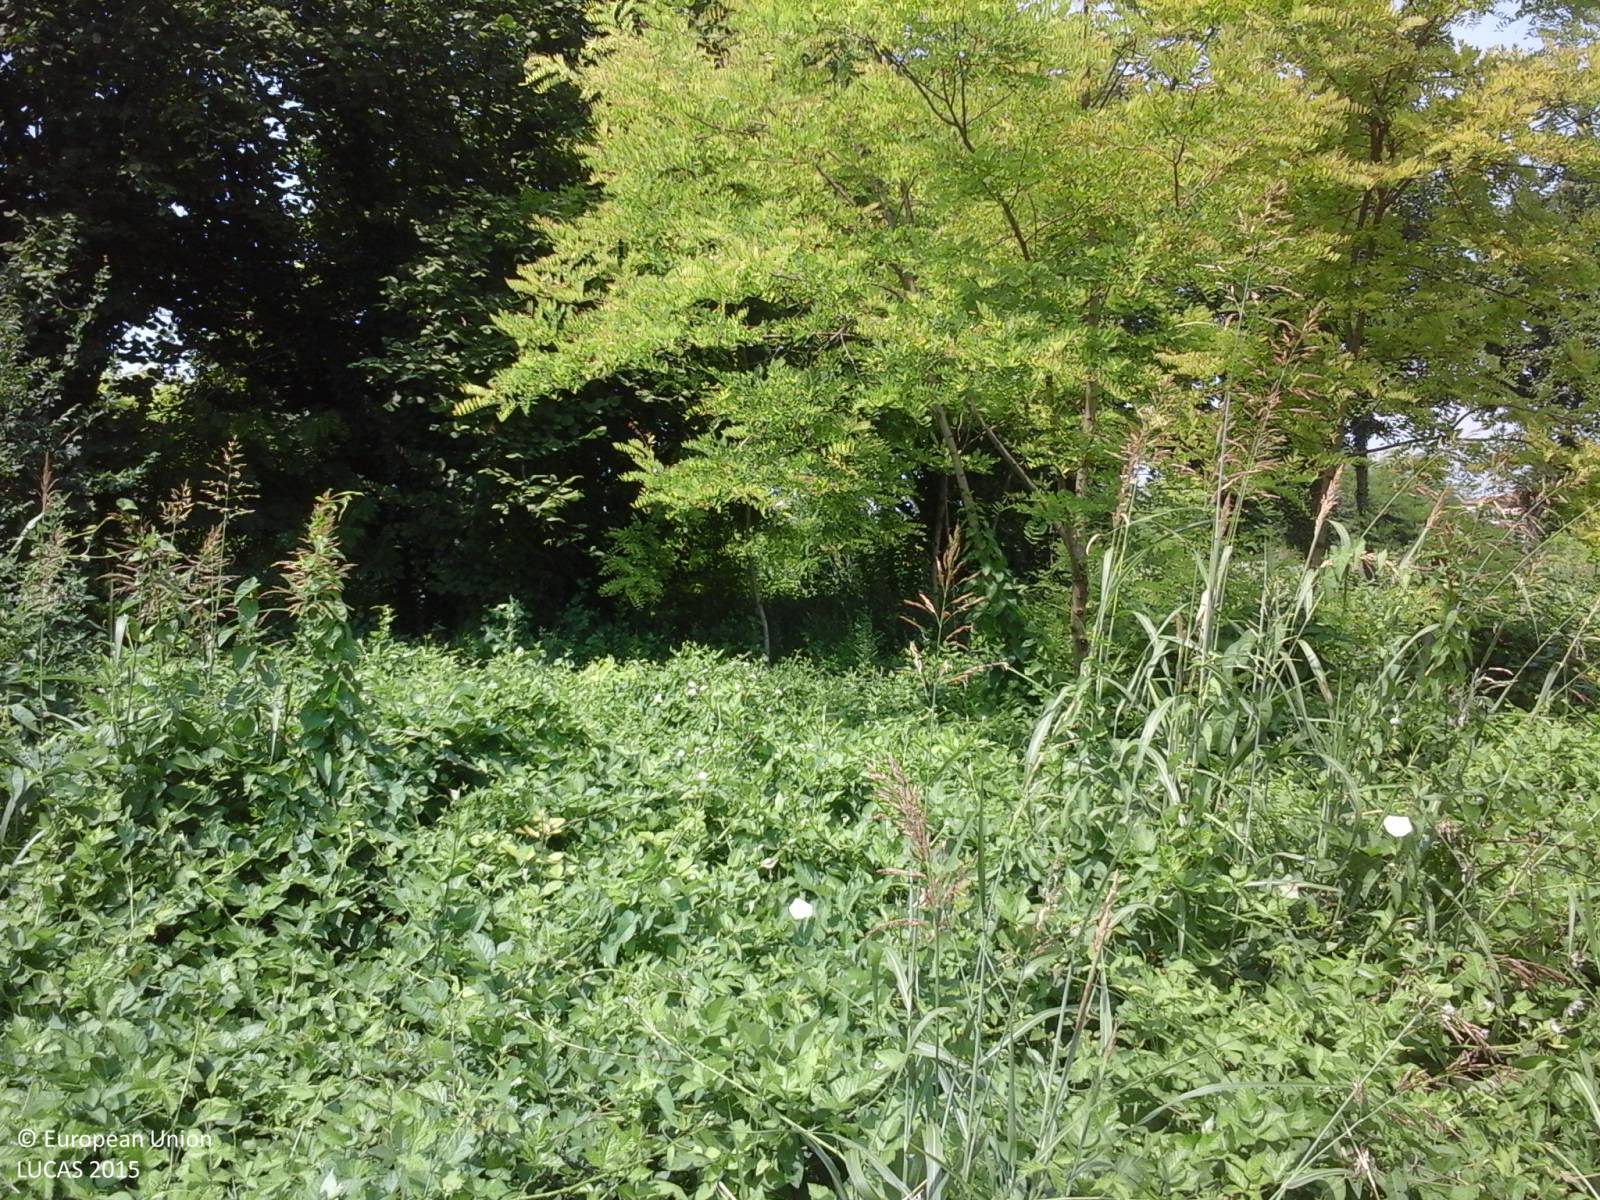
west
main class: Grassland
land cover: Spontaneously vegetated surfaces
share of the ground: > 75 %
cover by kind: herbaceous plants 100 %
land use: Agriculture (excluding fallow land and kitchen gardens)
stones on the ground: 10 - 25 %
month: July
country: IT
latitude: 45.9755
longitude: 12.6683
